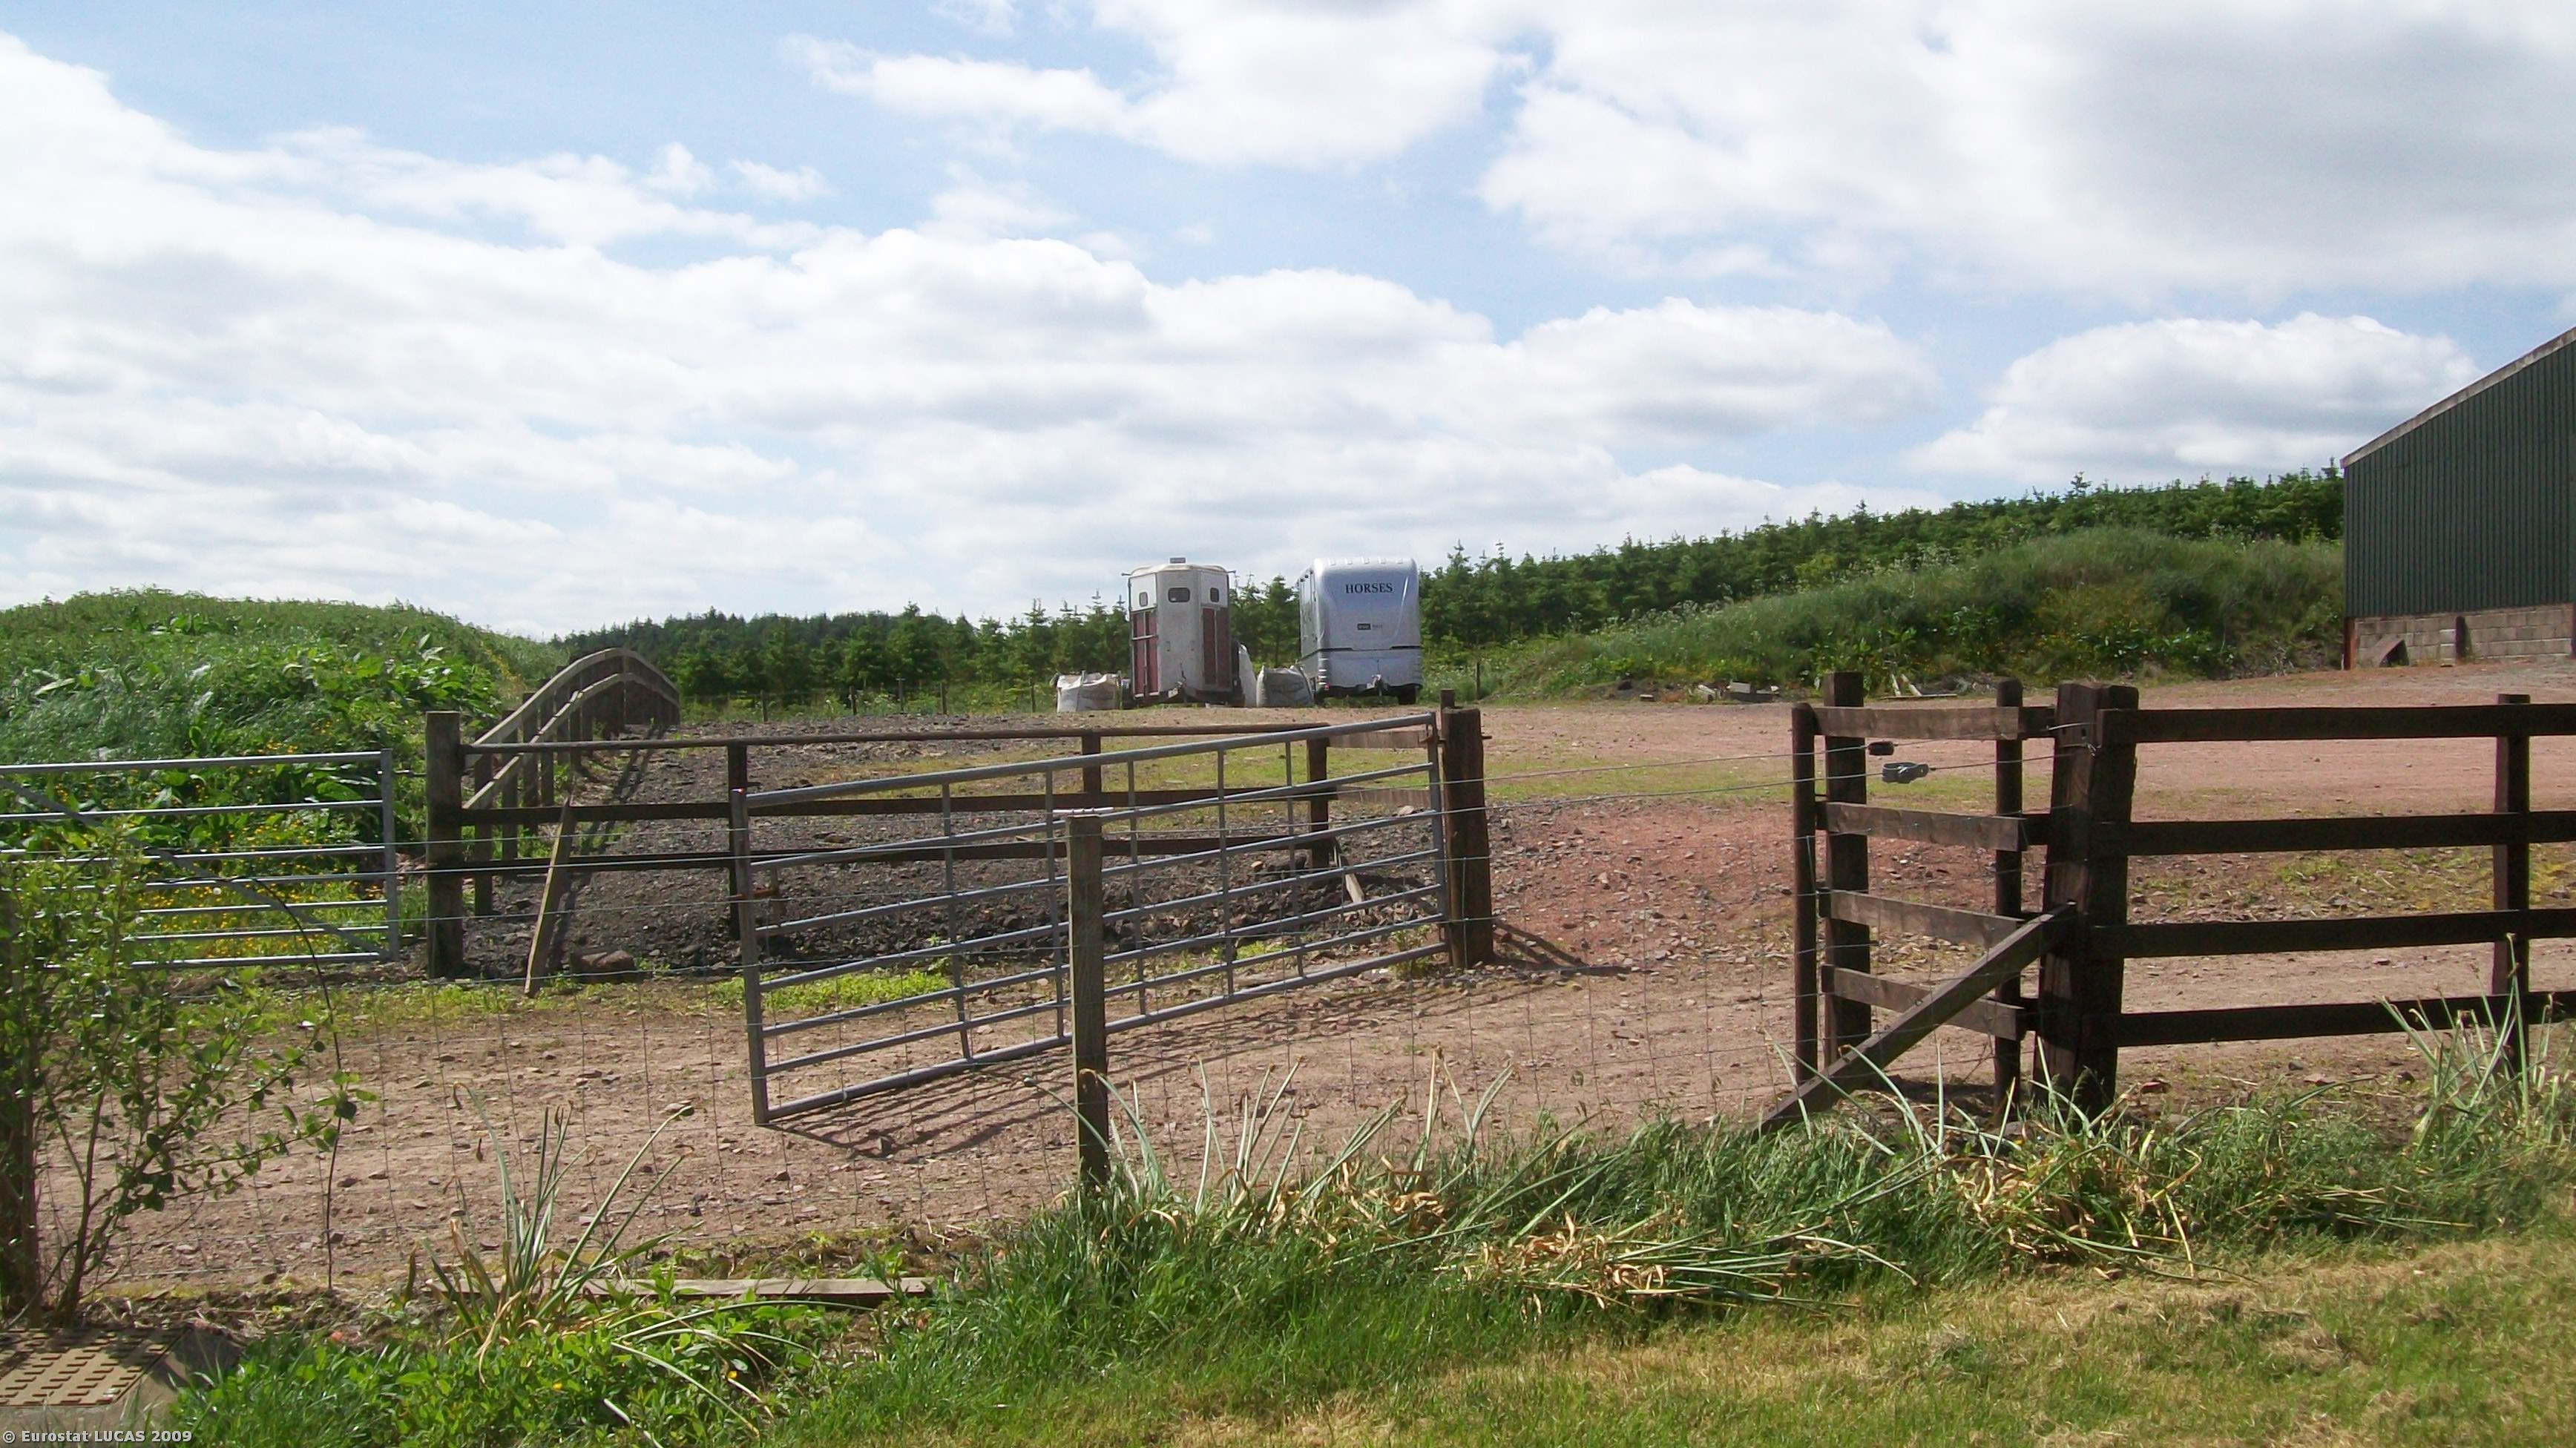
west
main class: Artificial land
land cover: Non built-up area features
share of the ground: > 75 %
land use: Residential
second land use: Agriculture (excluding fallow land and kitchen gardens)
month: June
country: GB
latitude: 55.6693
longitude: -3.5134
